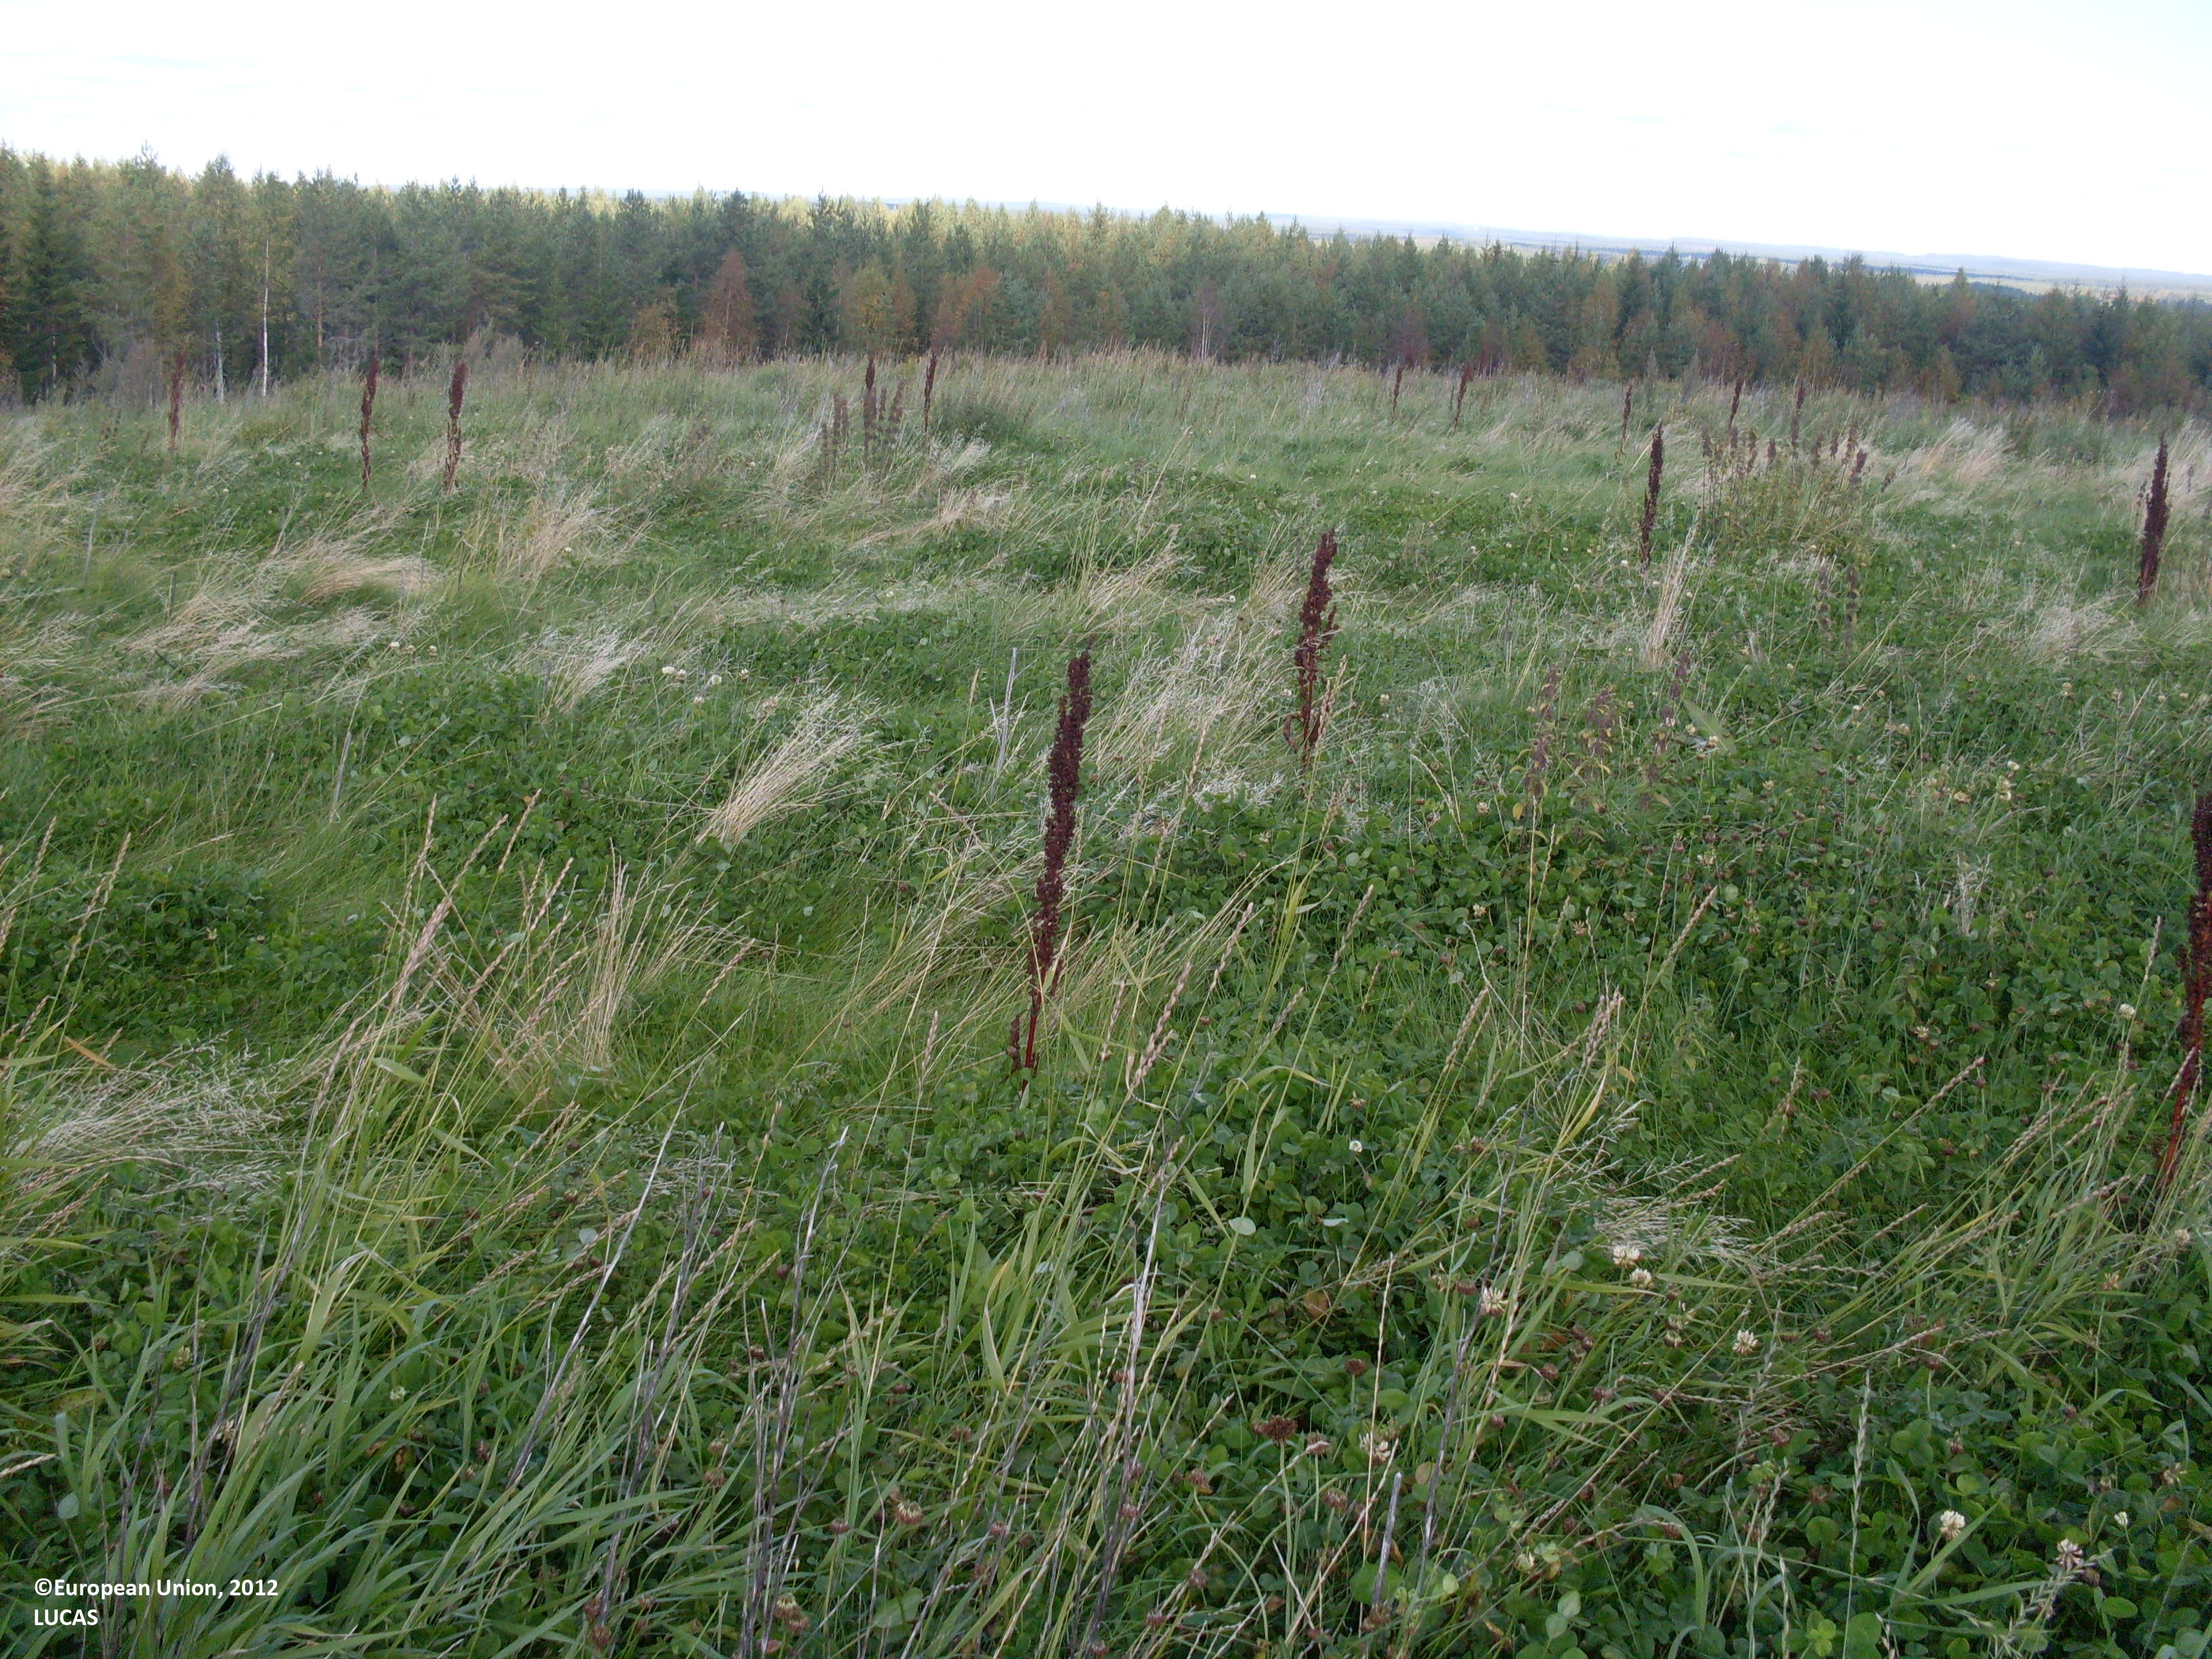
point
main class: Grassland
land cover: Grassland without tree/shrub cover
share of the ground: > 75 %
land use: Abandoned areas
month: September
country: FI
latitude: 64.0470
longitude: 29.3635
